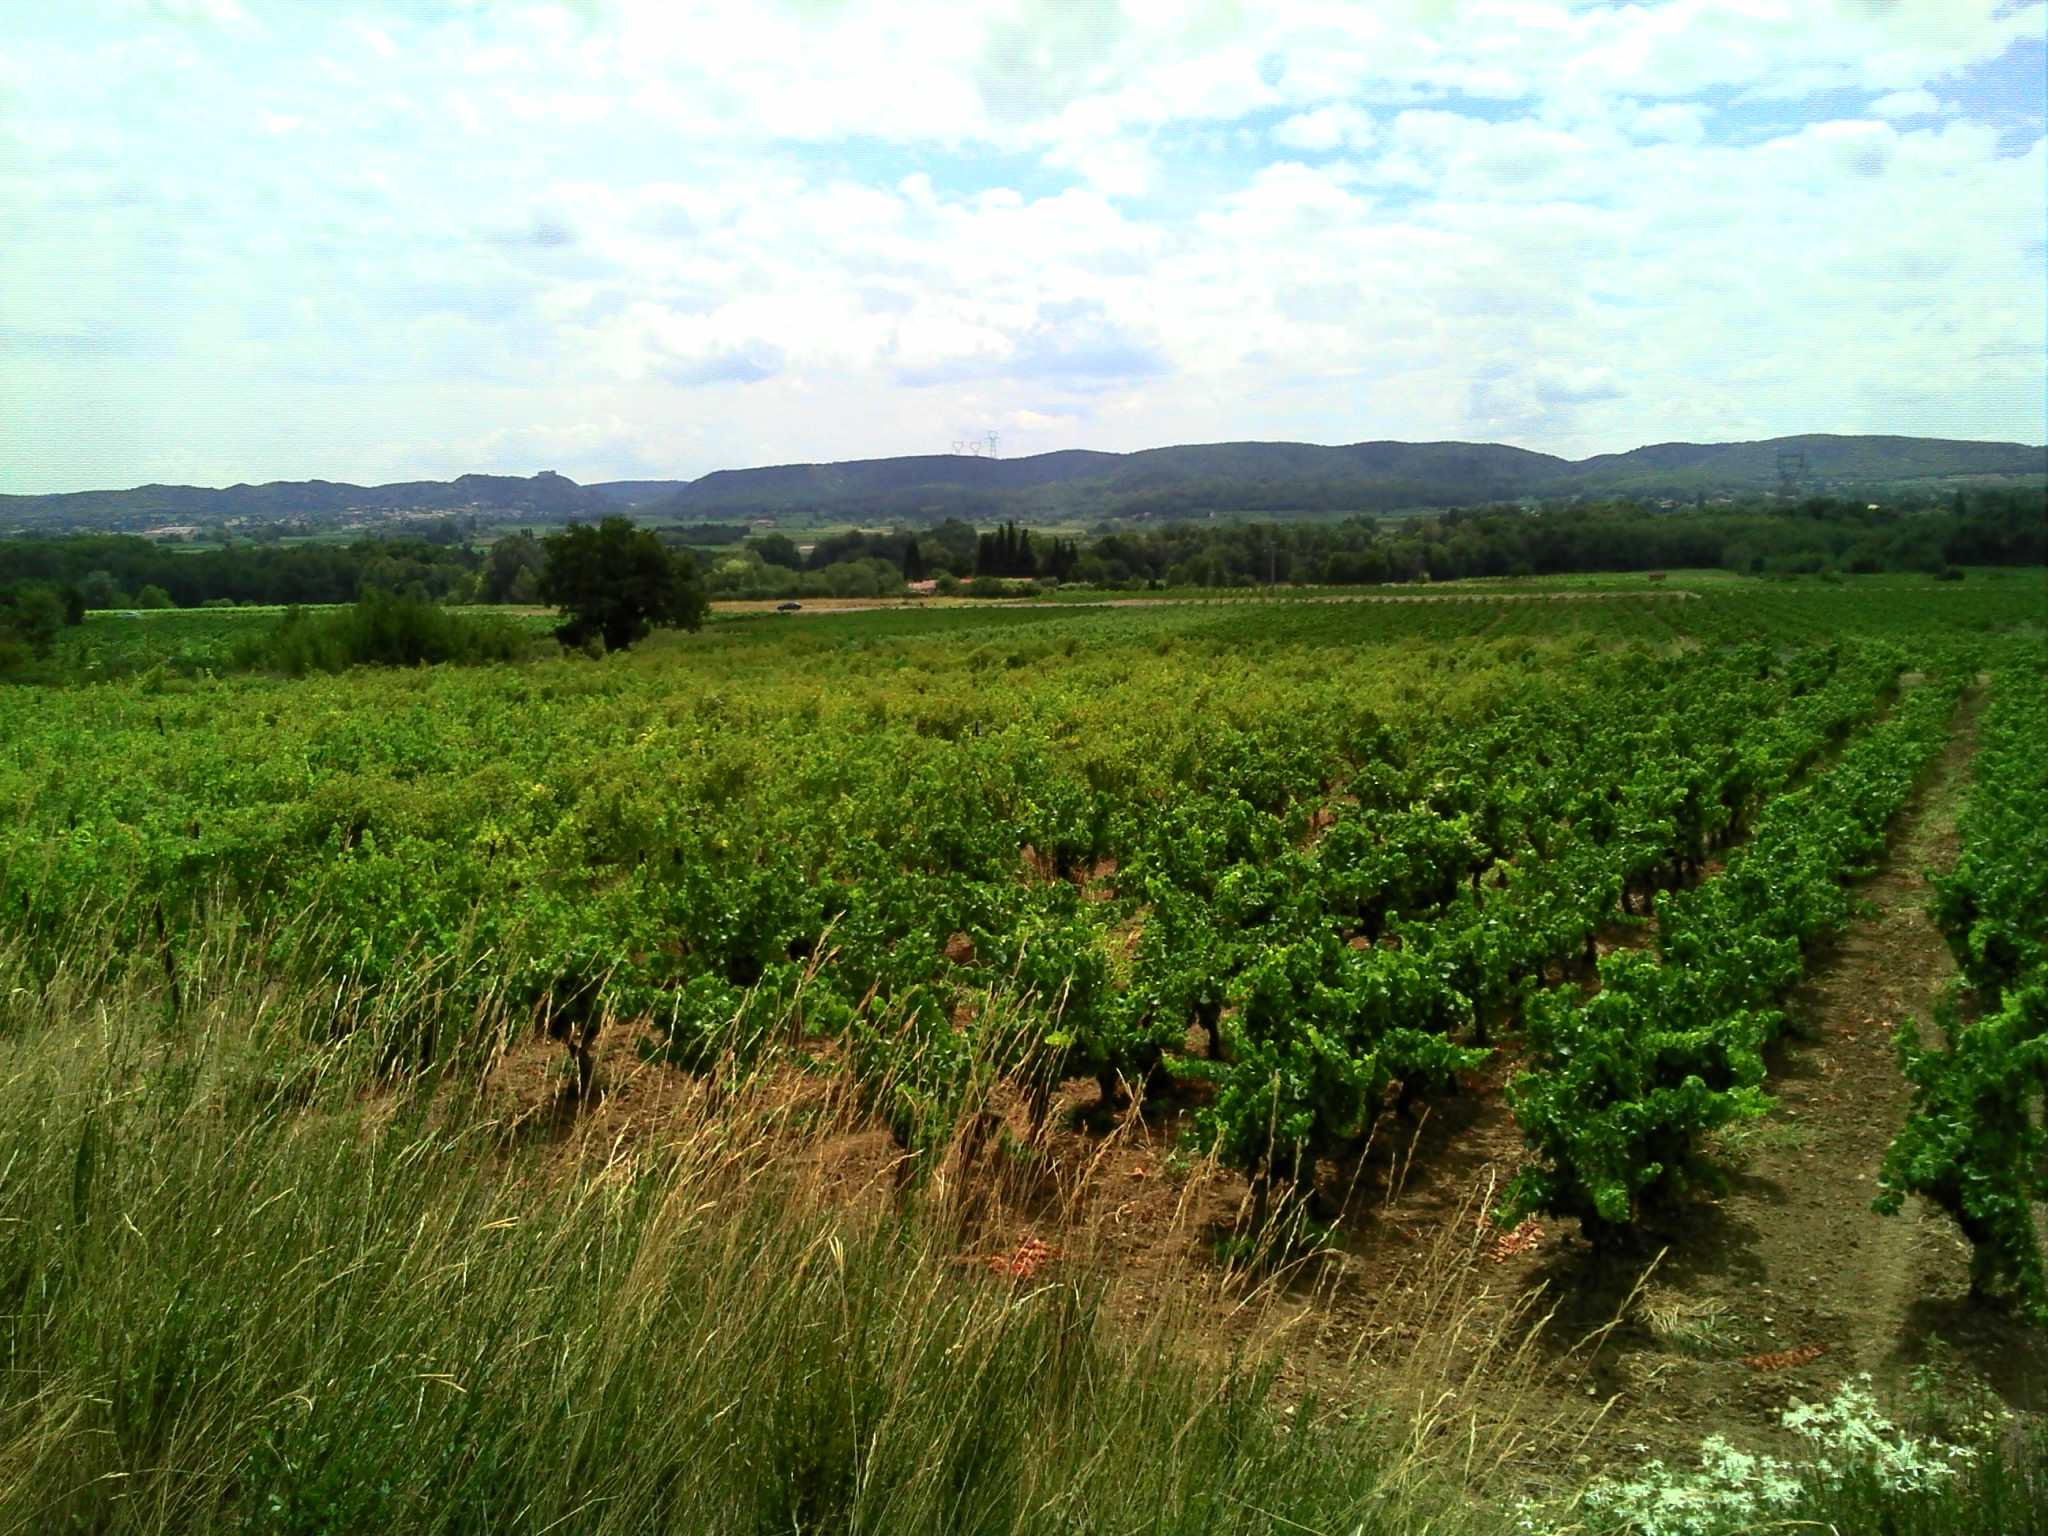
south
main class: Cropland
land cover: Vineyards
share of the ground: 10 - 25 %
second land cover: Spontaneously vegetated surfaces
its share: 50 - 75 %
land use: Agriculture (excluding fallow land and kitchen gardens)
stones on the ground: < 10 %
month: August
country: FR
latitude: 44.1028
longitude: 4.6238
